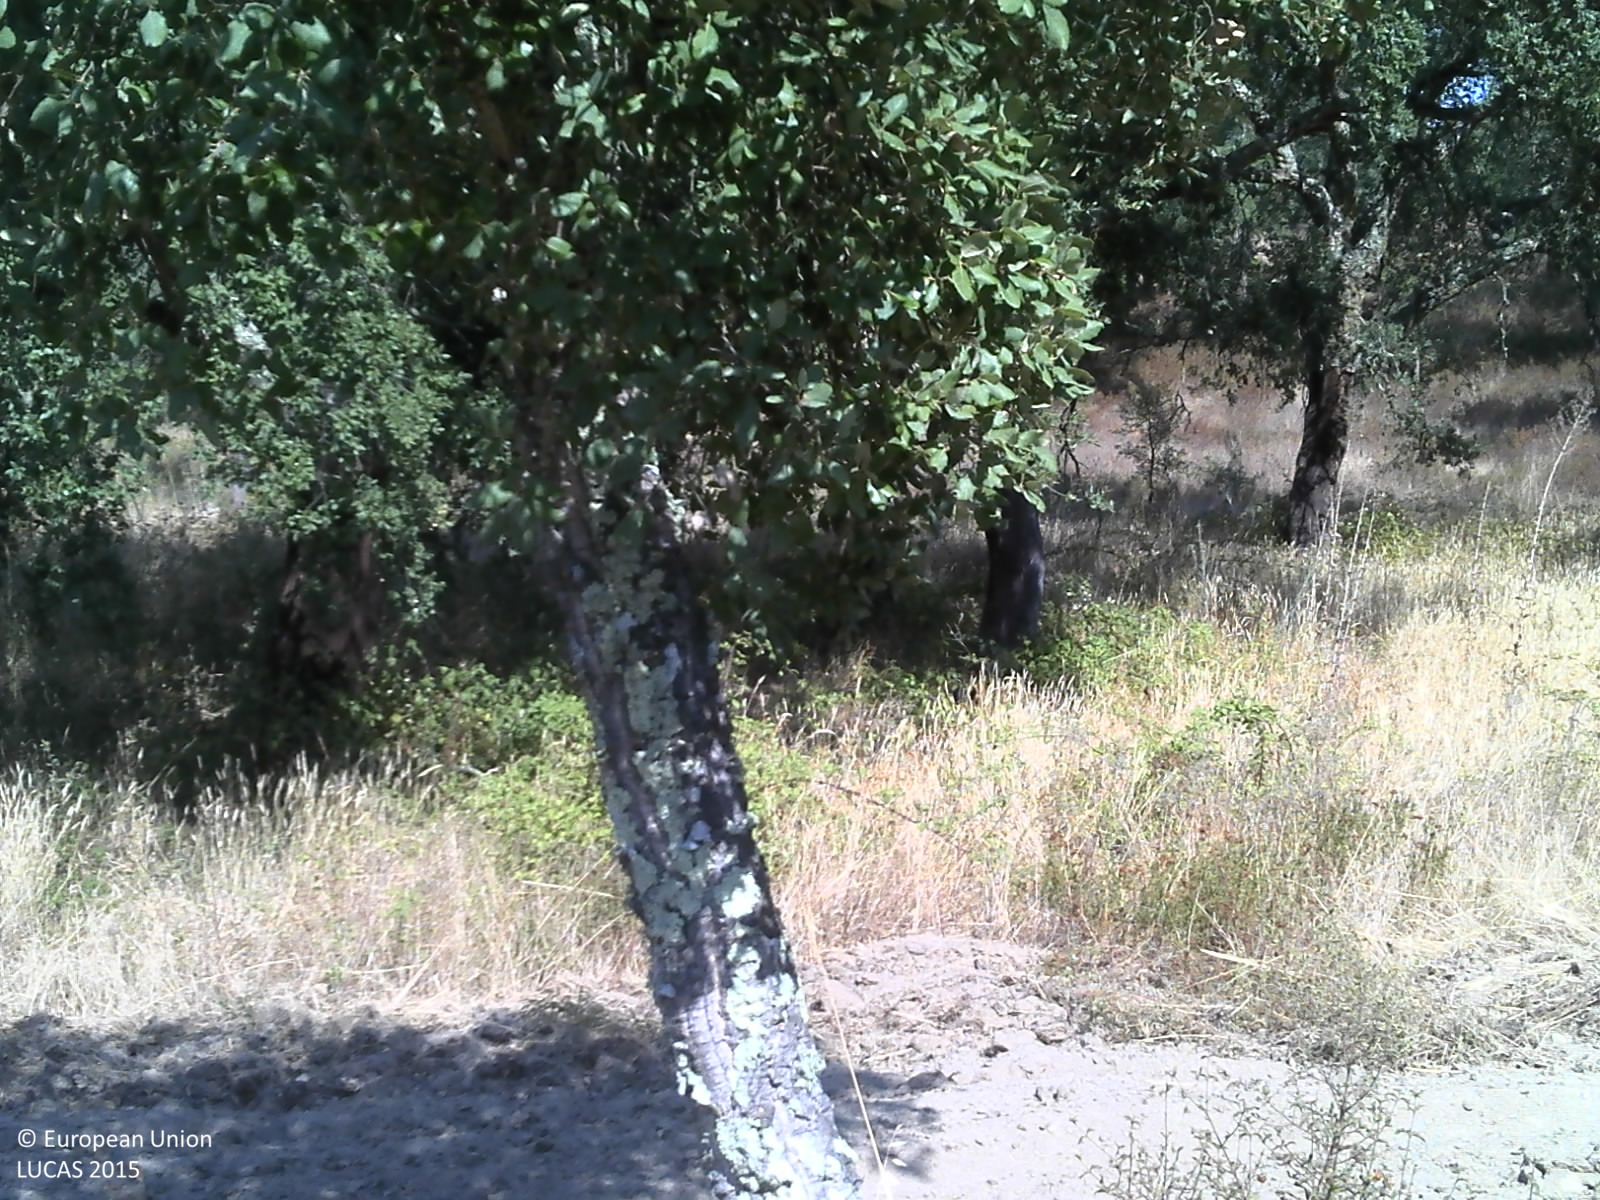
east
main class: Woodland
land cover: Pine dominated coniferous woodland
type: coniferous forest of the mediterranean region
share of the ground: 25 - 50 %
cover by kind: coniferous forest trees 50 %, herbaceous plants 35 %, unconsolidated bare surface 15 %
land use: Forestry
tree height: < 5 m
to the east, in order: Pine dominated coniferous woodland; Shruby margins; Tracks; Shrubland without tree cover; Tracks; Shrubland without tree cover; Rivers and streams; Fences; Shrubland without tree cover; Other structural elements; Broadleaved woodland
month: August
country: PT
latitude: 38.7448
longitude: -8.5248
